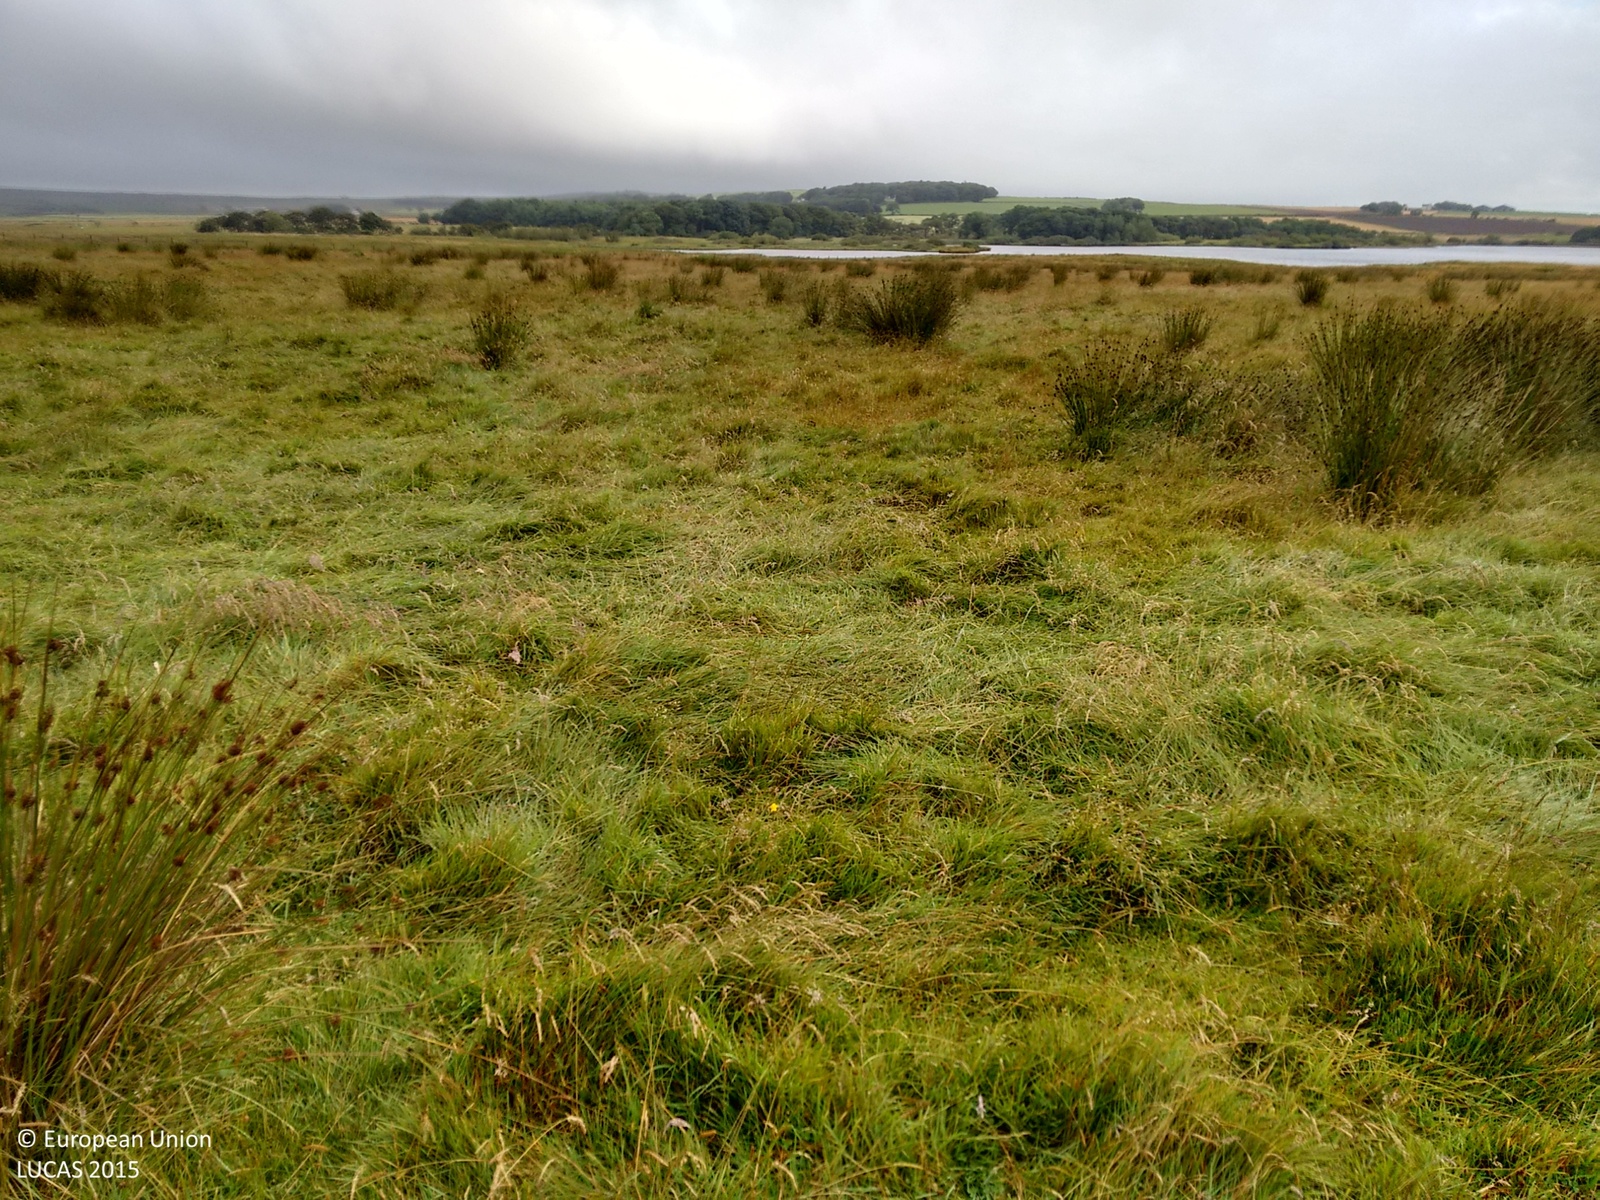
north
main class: Grassland
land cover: Grassland without tree/shrub cover
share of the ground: > 75 %
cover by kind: herbaceous plants 100 %
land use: Agriculture (excluding fallow land and kitchen gardens)
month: September
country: GB
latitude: 58.5130
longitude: -3.4003
